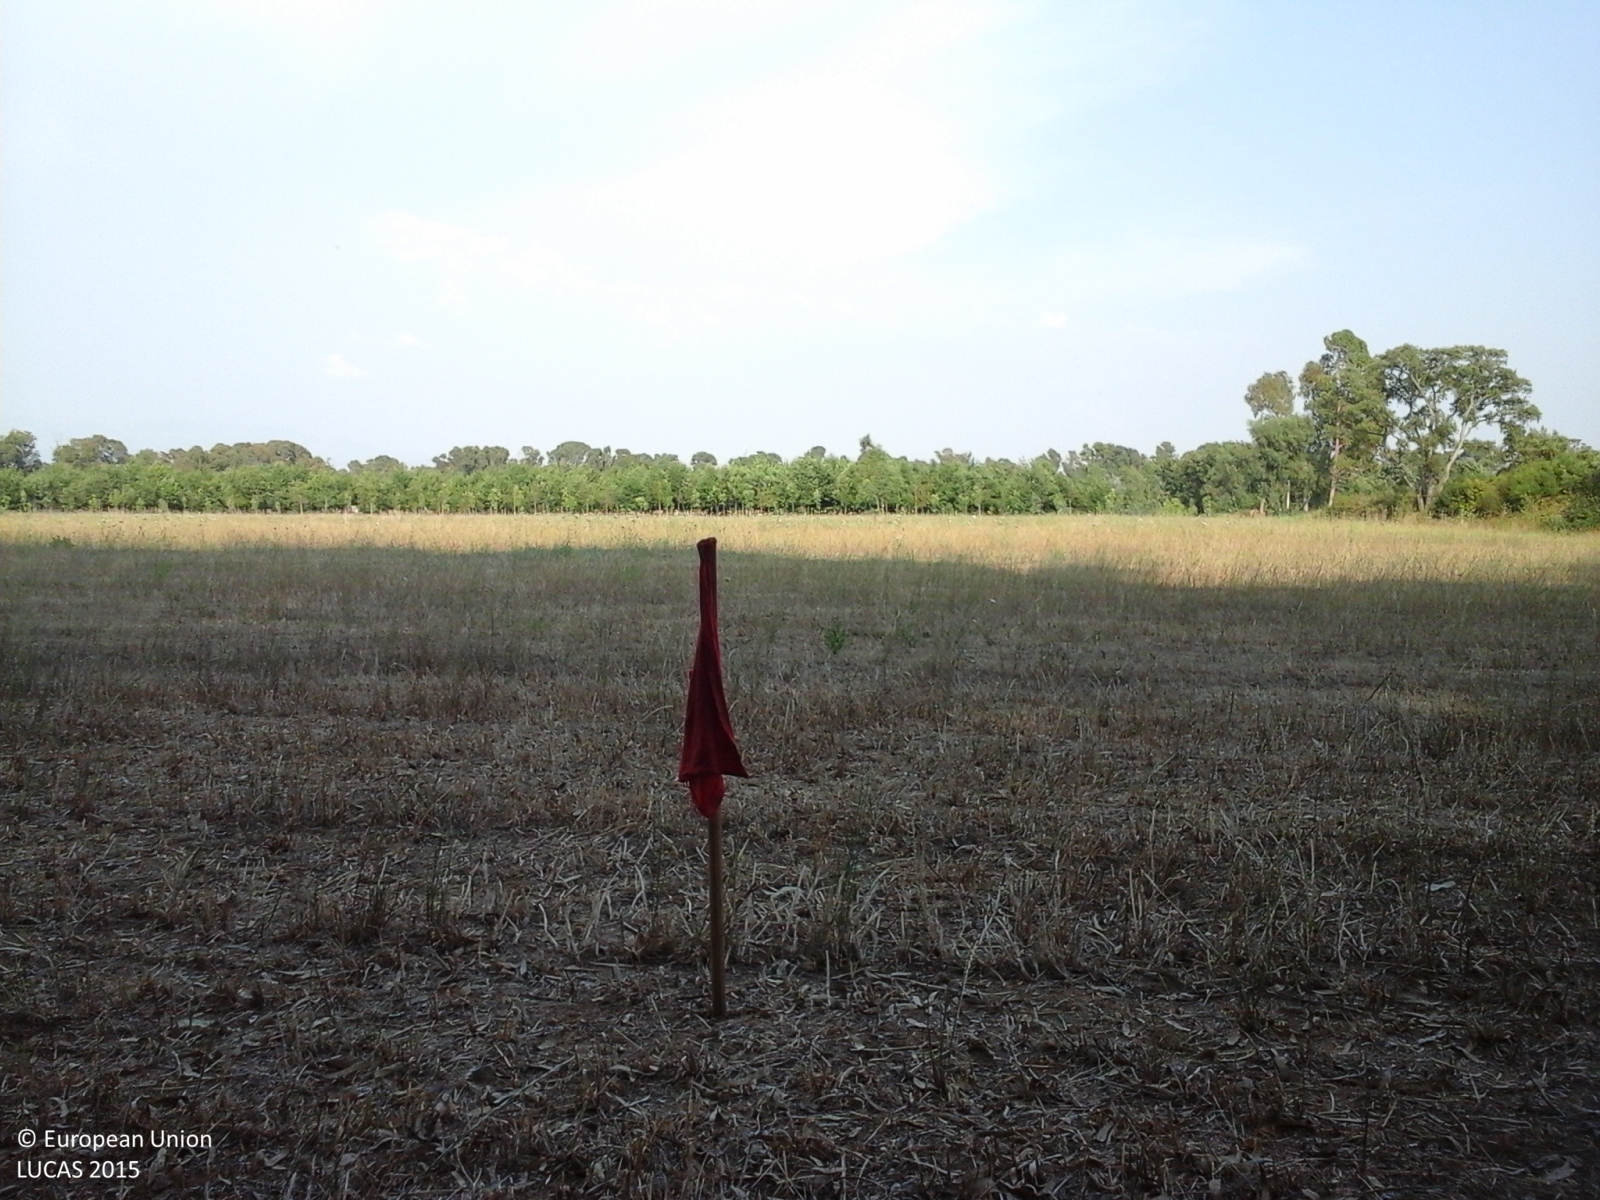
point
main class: Cropland
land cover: Temporary grasslands
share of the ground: > 75 %
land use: Agriculture (excluding fallow land and kitchen gardens)
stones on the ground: < 10 %
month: July
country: IT
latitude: 41.4762
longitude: 12.8029
